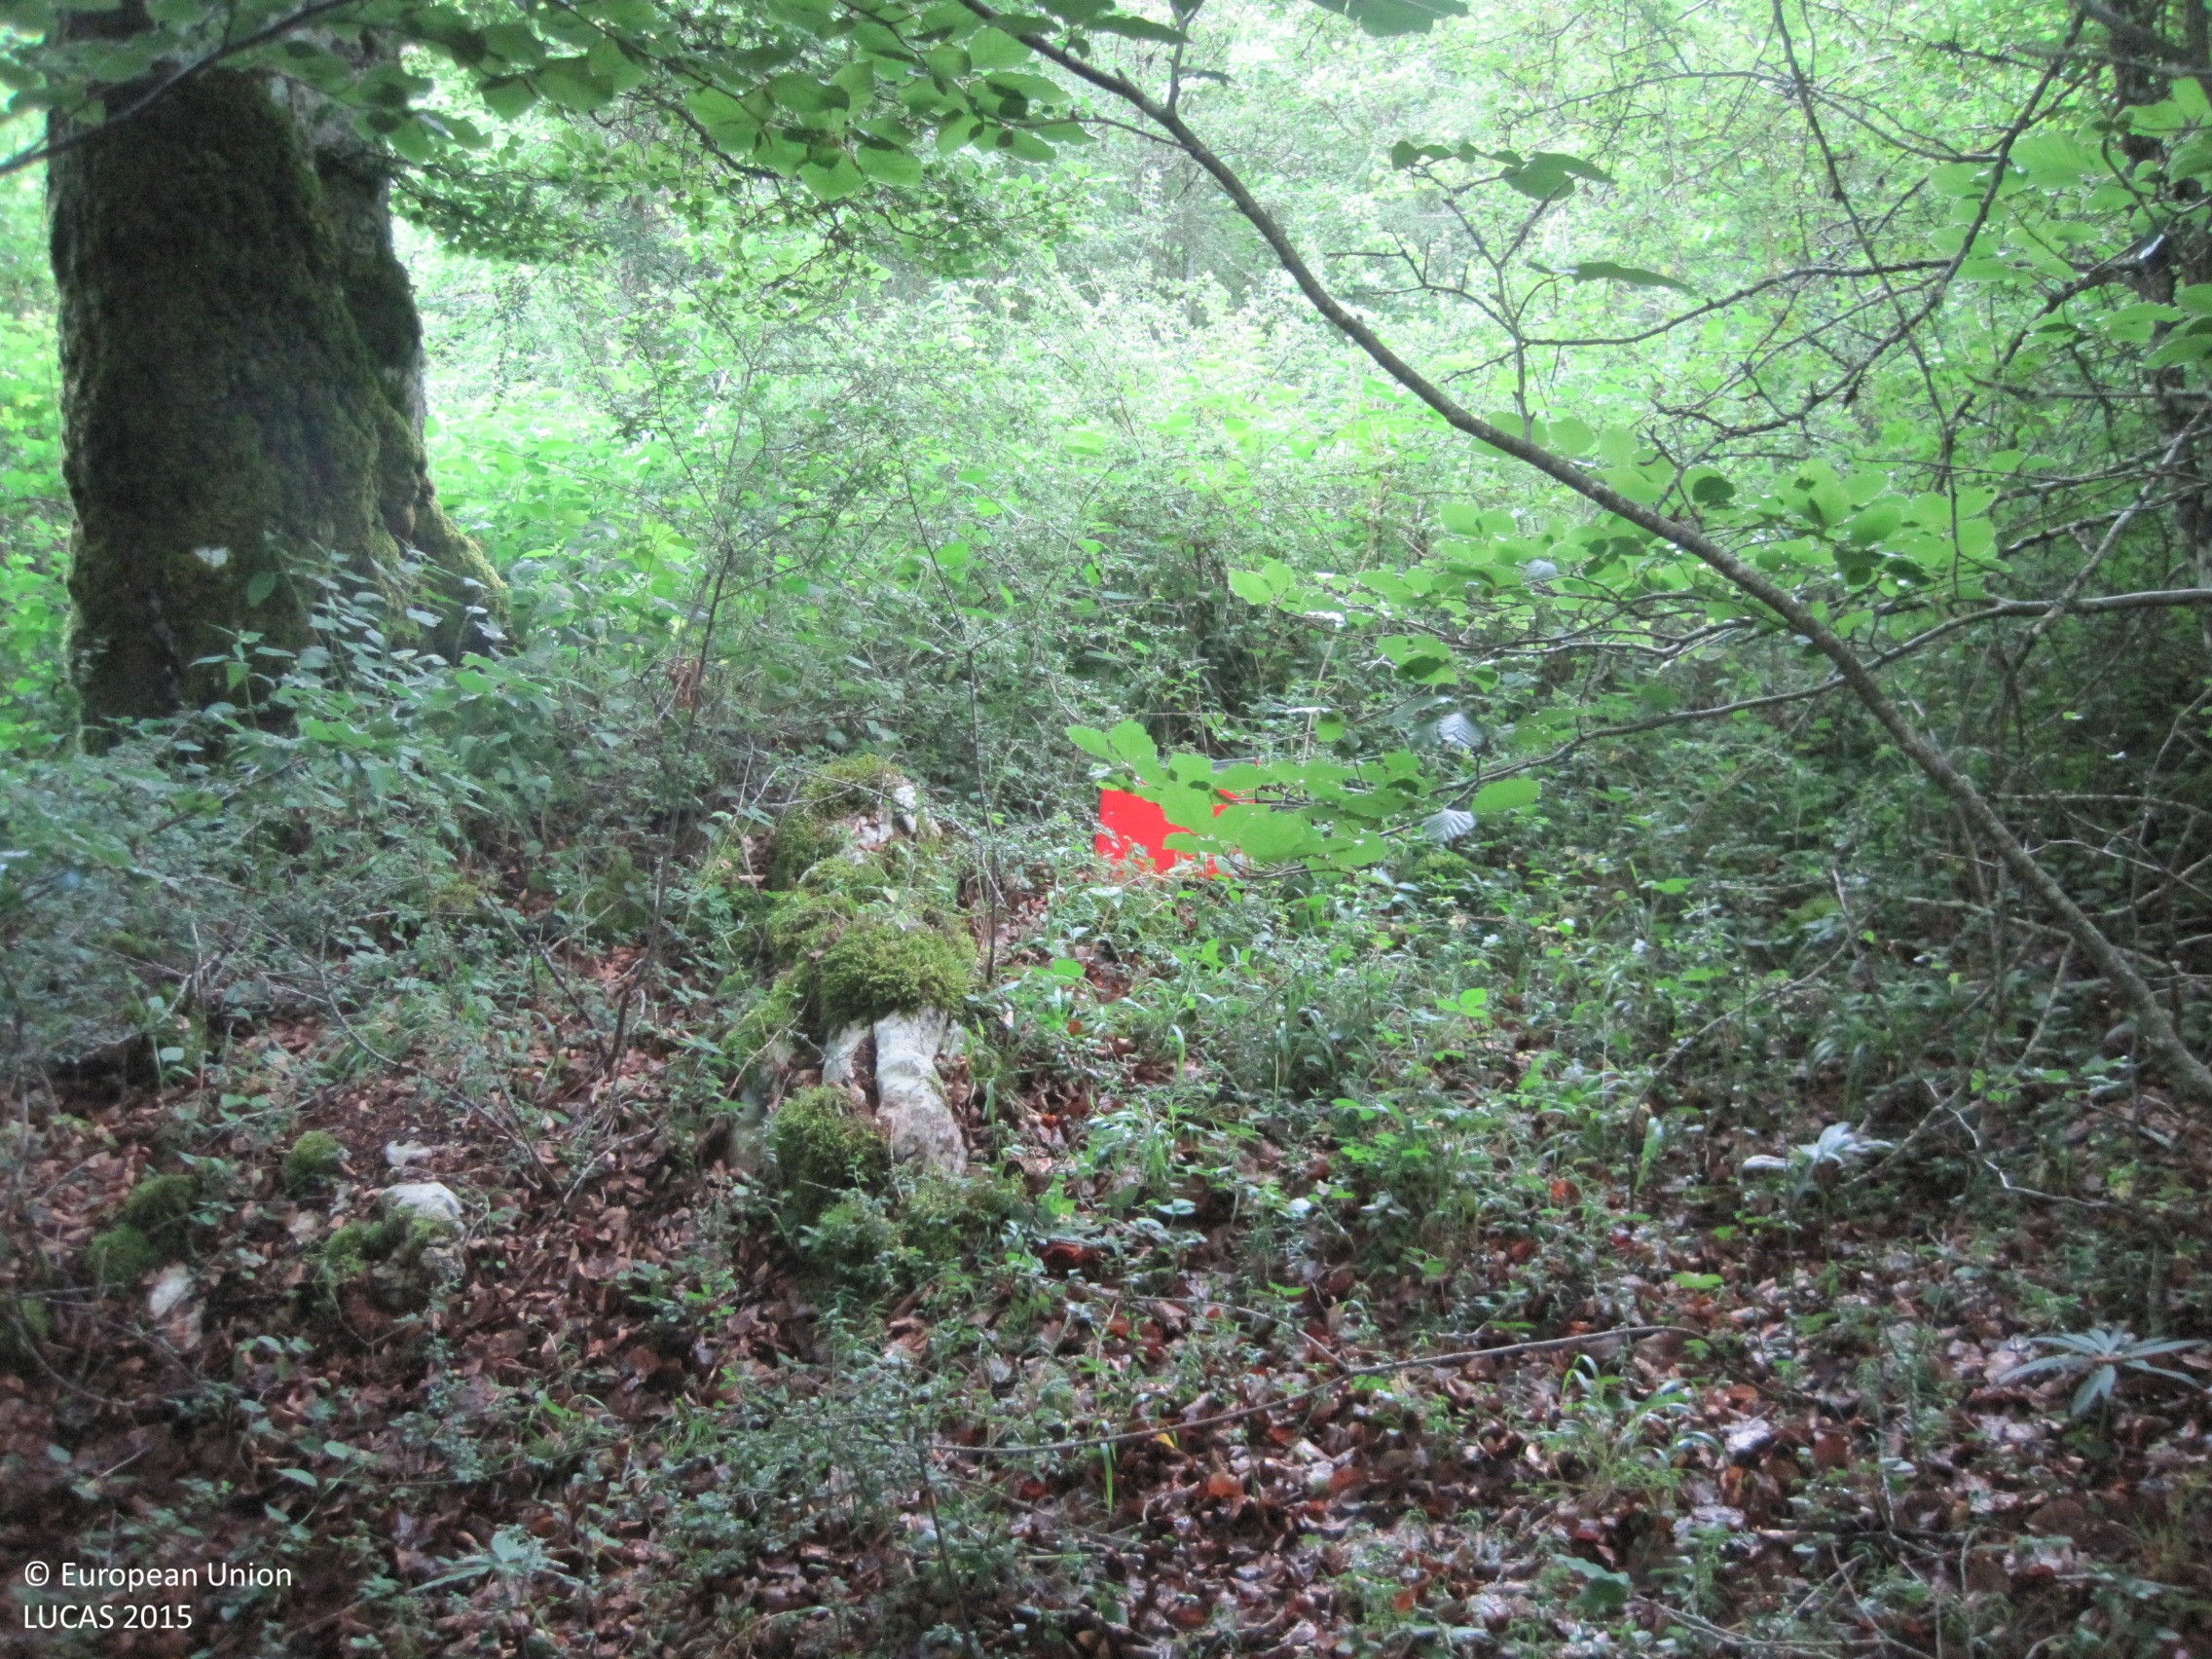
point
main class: Woodland
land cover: Broadleaved woodland
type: beech forest
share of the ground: > 75 %
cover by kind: broadleaved forest trees 100 %
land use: Forestry
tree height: > 5 m
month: June
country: ES
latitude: 42.7939
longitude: -2.1605
